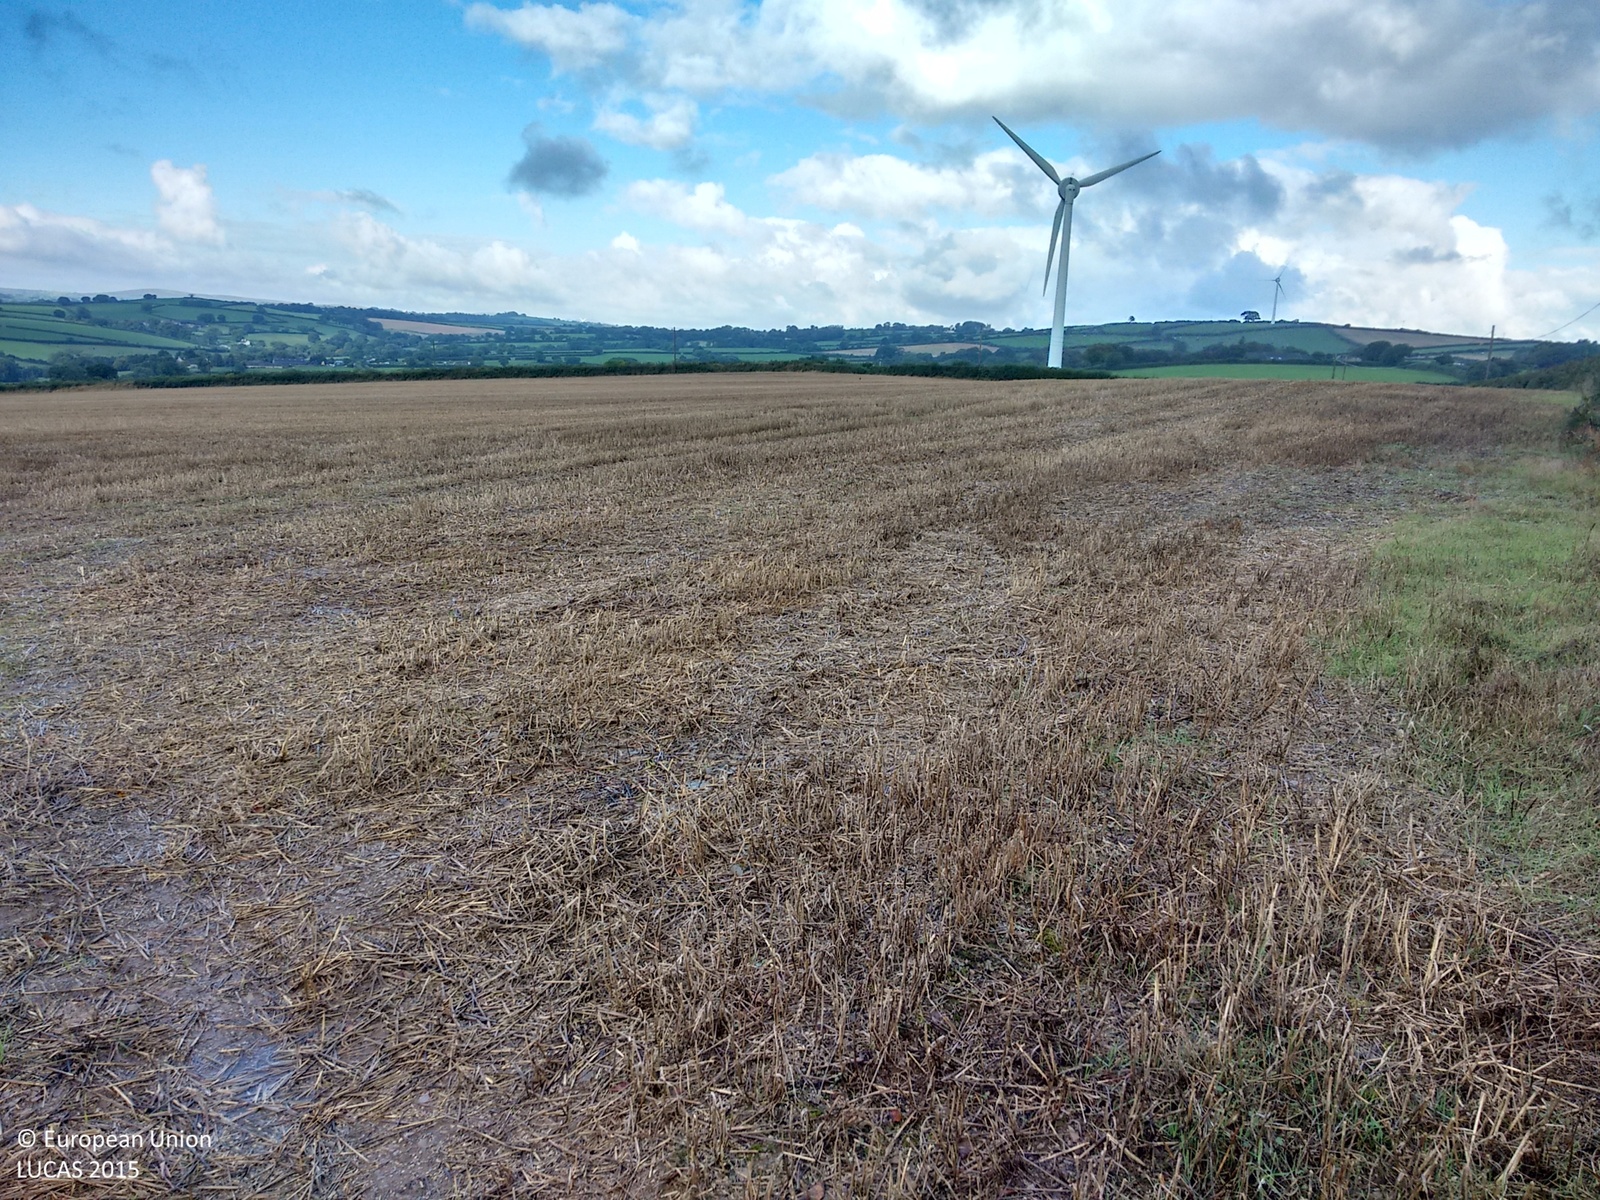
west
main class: Cropland
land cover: Common wheat
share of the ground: 25 - 50 %
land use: Agriculture (excluding fallow land and kitchen gardens)
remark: Harvested field
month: September
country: GB
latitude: 50.6031
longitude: -4.3578
